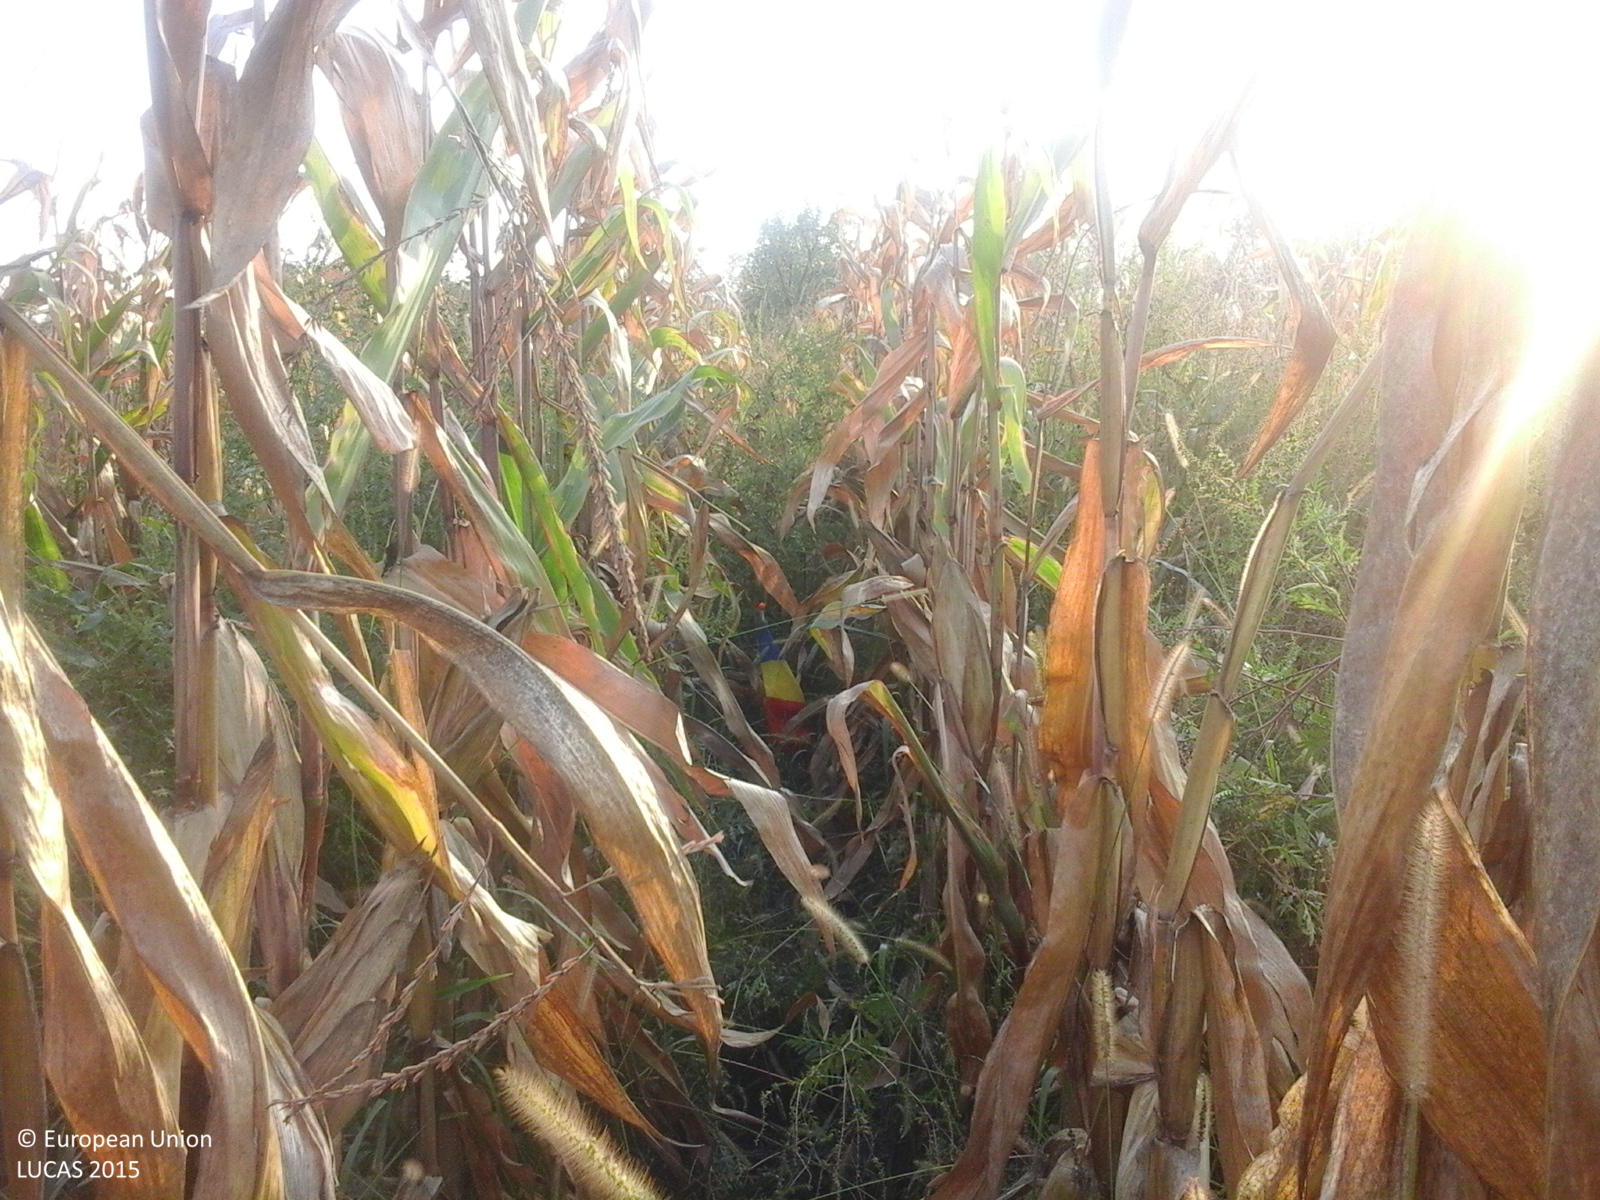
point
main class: Cropland
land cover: Maize
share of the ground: > 75 %
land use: Agriculture (excluding fallow land and kitchen gardens)
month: September
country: RO
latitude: 45.5471
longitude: 22.1446
